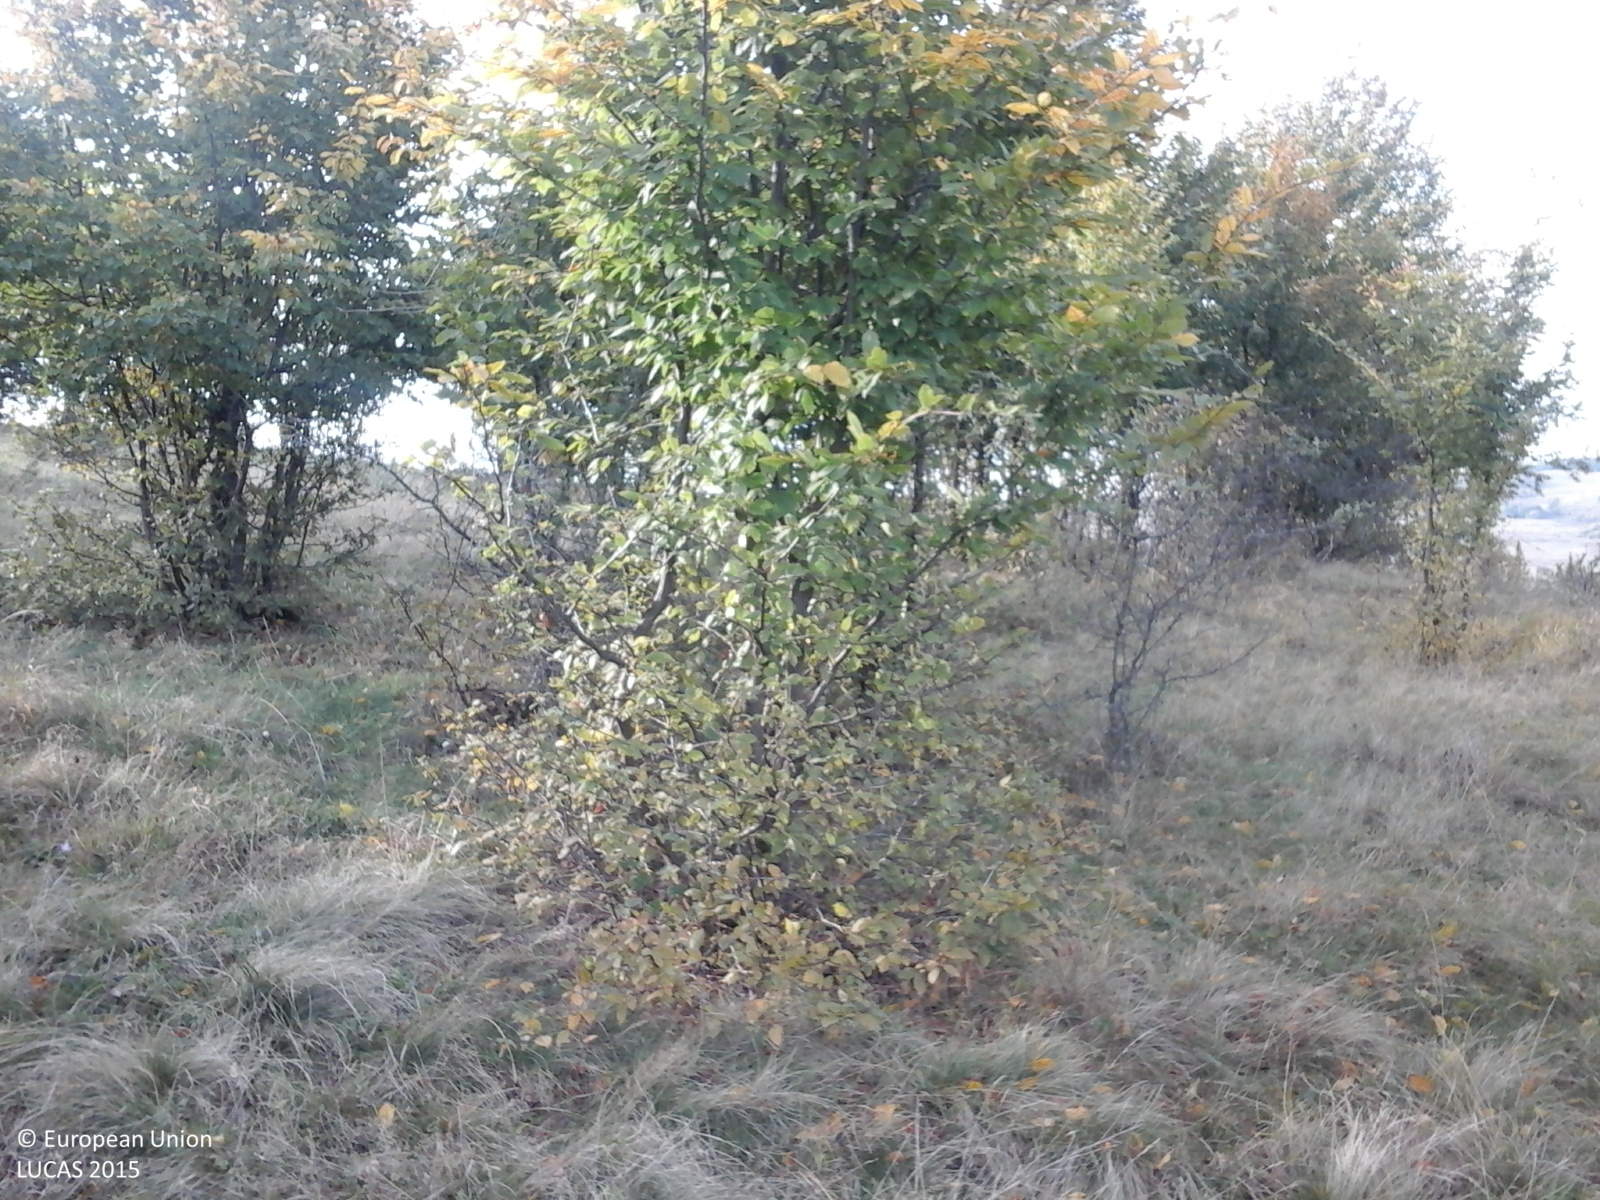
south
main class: Grassland
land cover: Grassland with sparse tree/shrub cover
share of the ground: > 75 %
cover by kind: herbaceous plants 85 %, shrubs 10 %, broadleaved forest trees 5 %
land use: Fallow land
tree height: < 5 m
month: October
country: RO
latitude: 46.2020
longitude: 25.2507
